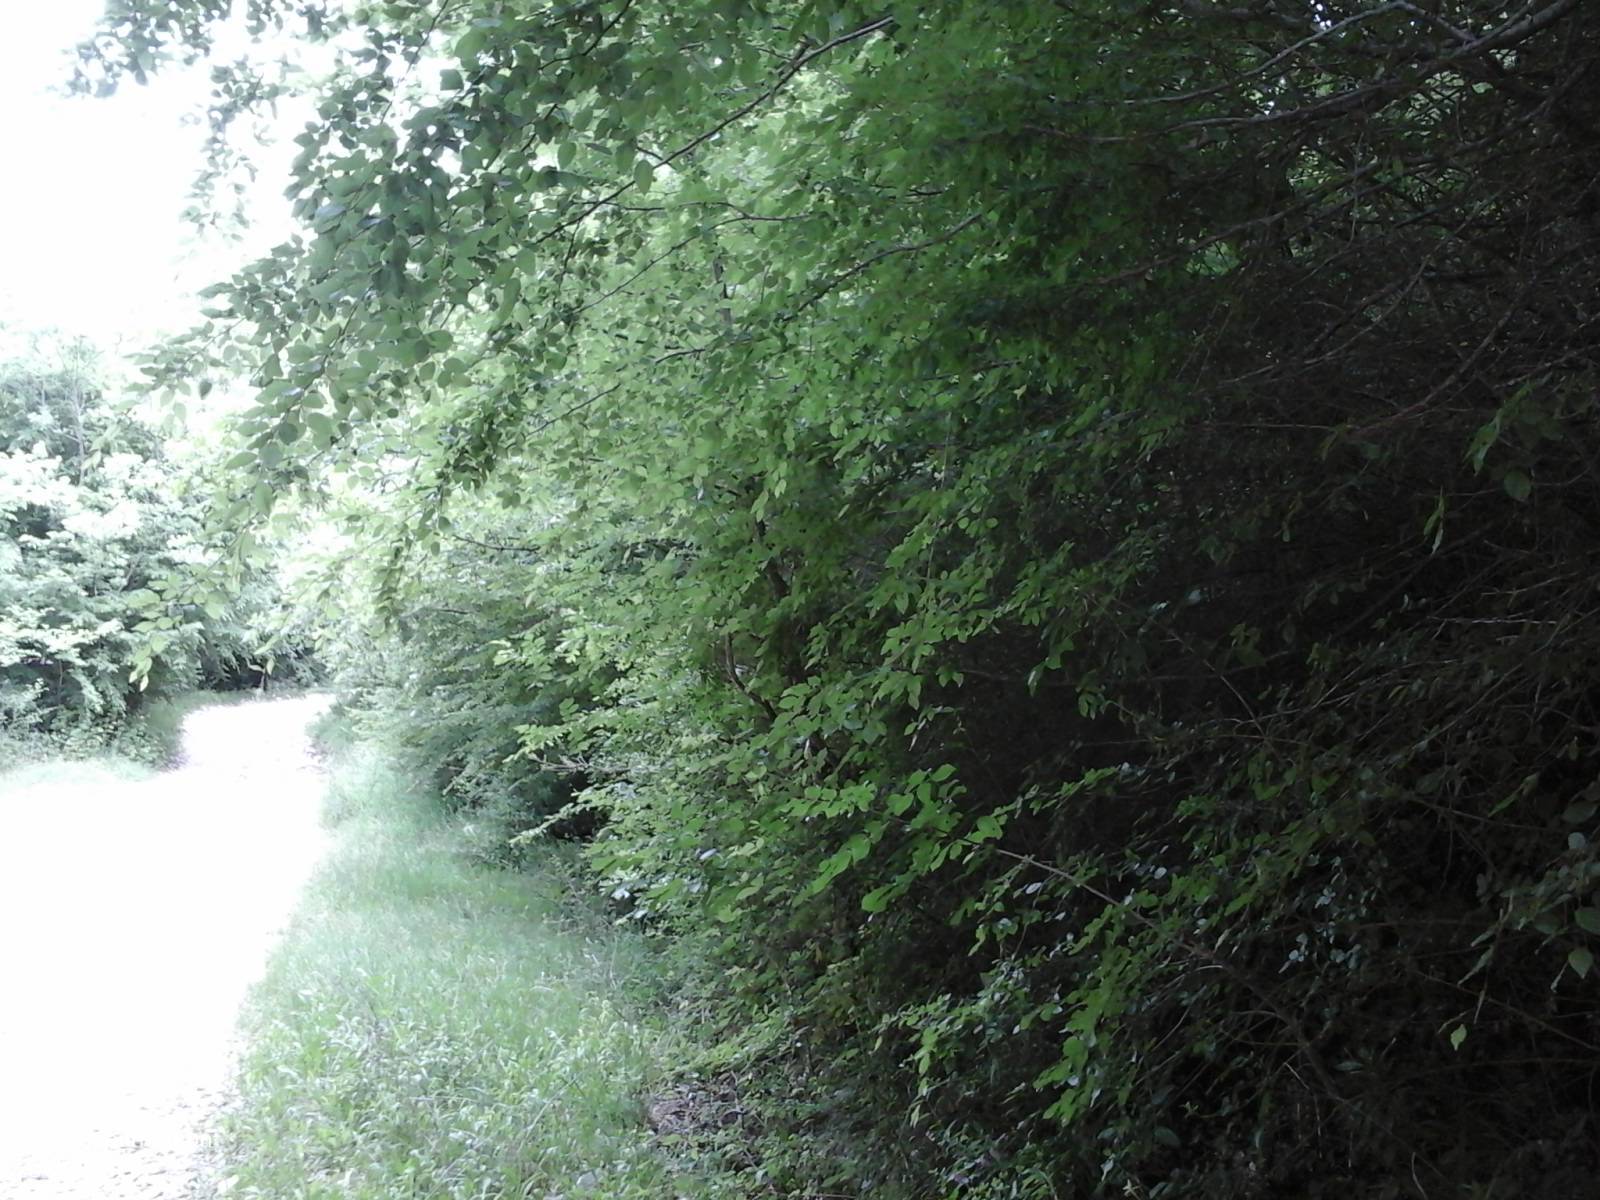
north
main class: Woodland
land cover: Broadleaved woodland
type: thermophilous deciduous forest
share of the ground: > 75 %
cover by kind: broadleaved forest trees 100 %
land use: Forestry
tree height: < 5 m
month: May
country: IT
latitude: 41.2432
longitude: 14.2673
